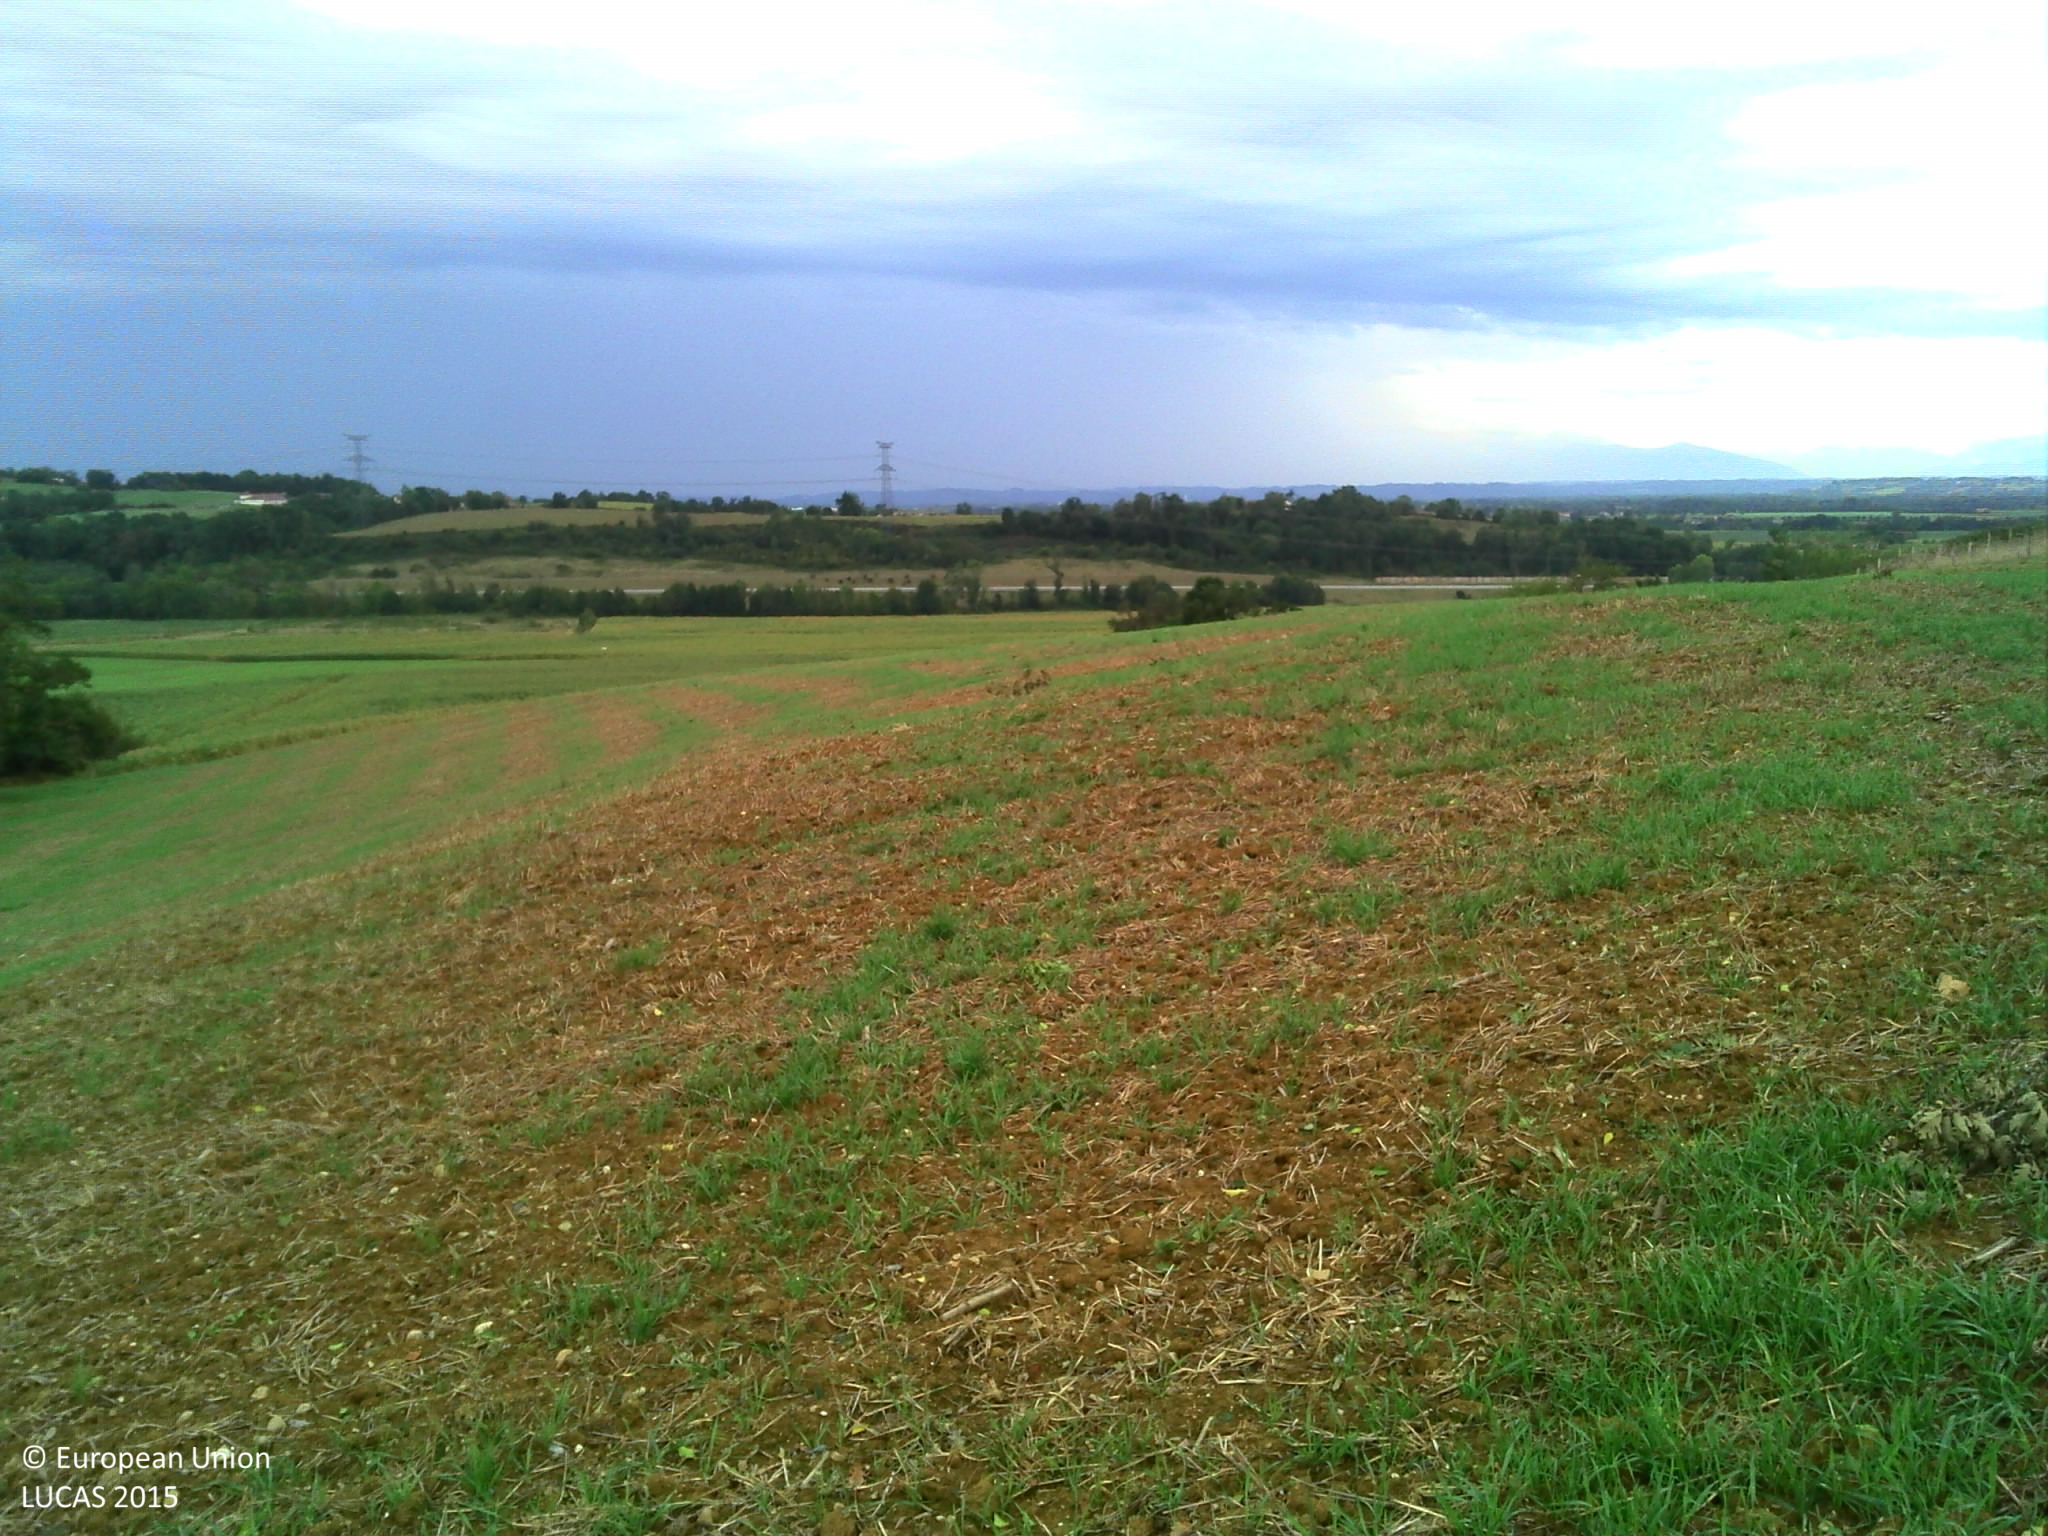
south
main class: Cropland
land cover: Common wheat
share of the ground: > 75 %
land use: Agriculture (excluding fallow land and kitchen gardens)
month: September
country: FR
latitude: 43.4424
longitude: -0.4241
